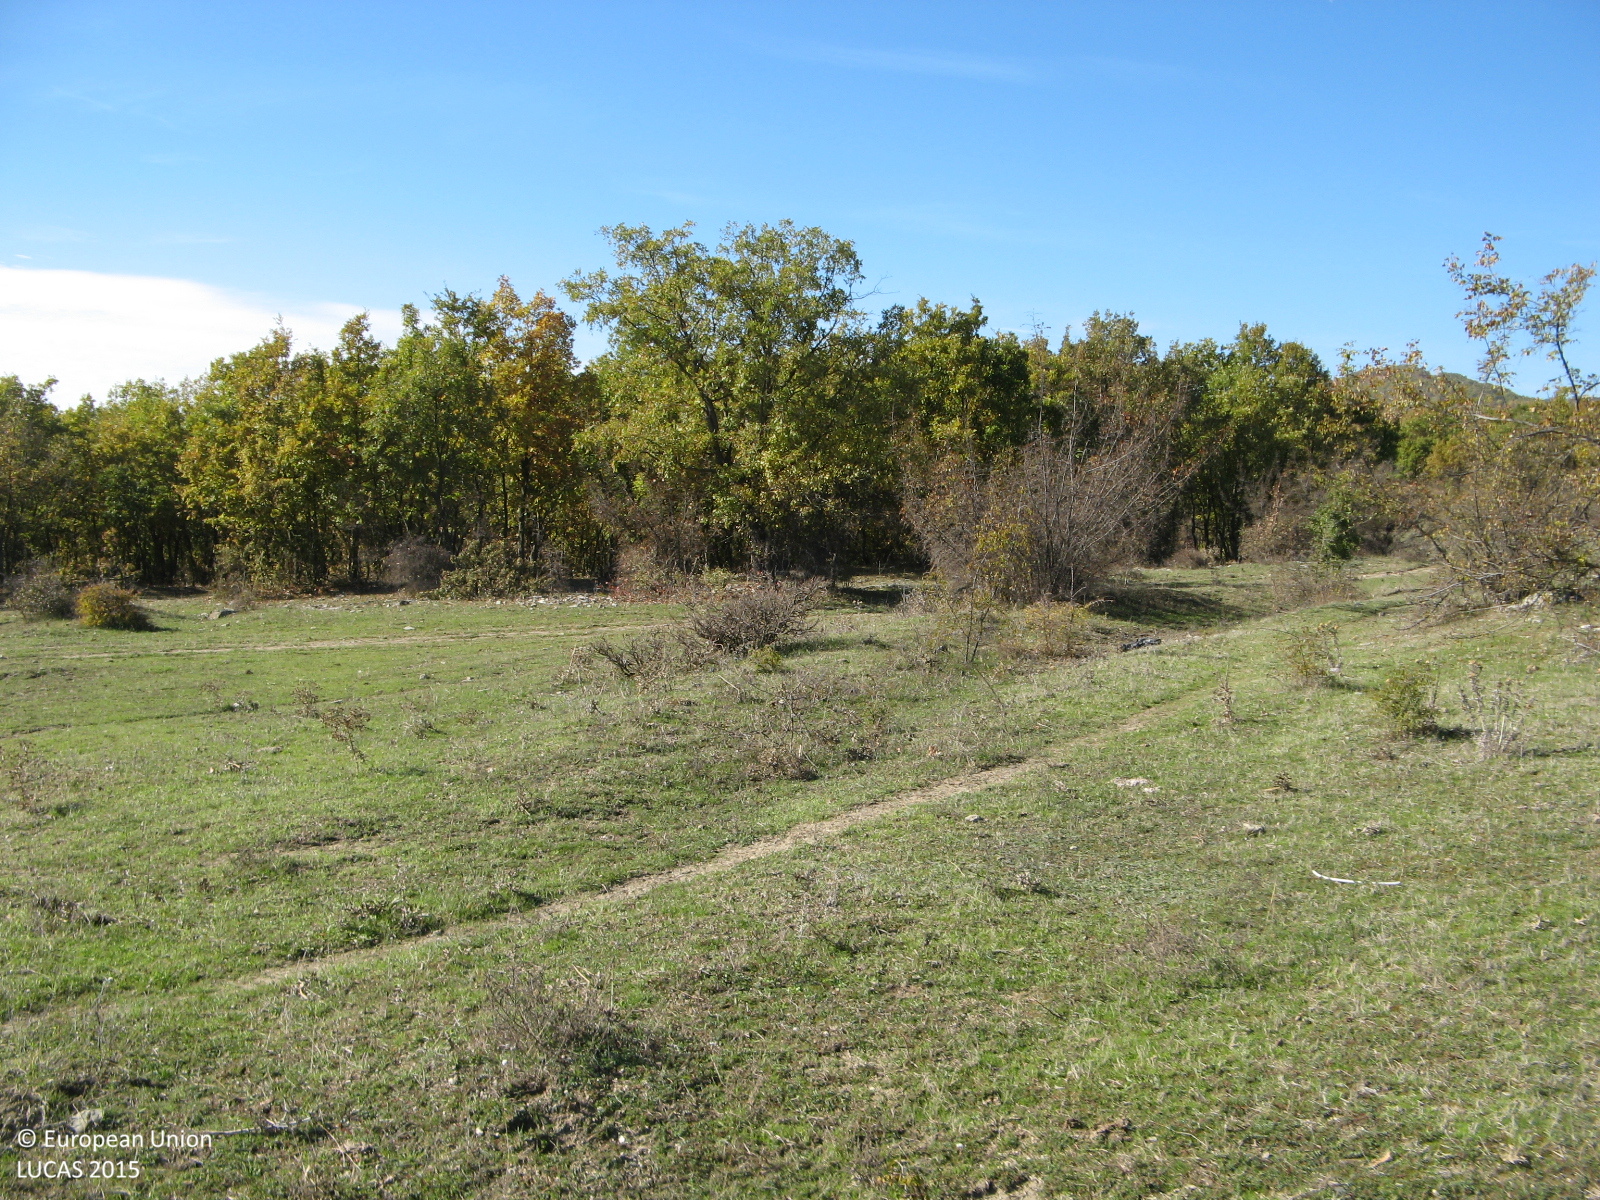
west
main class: Grassland
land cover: Grassland with sparse tree/shrub cover
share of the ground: > 75 %
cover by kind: herbaceous plants 85 %, shrubs 10 %, broadleaved forest trees 5 %
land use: Agriculture (excluding fallow land and kitchen gardens)
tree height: < 5 m
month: November
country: BG
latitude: 41.5647
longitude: 25.3689
